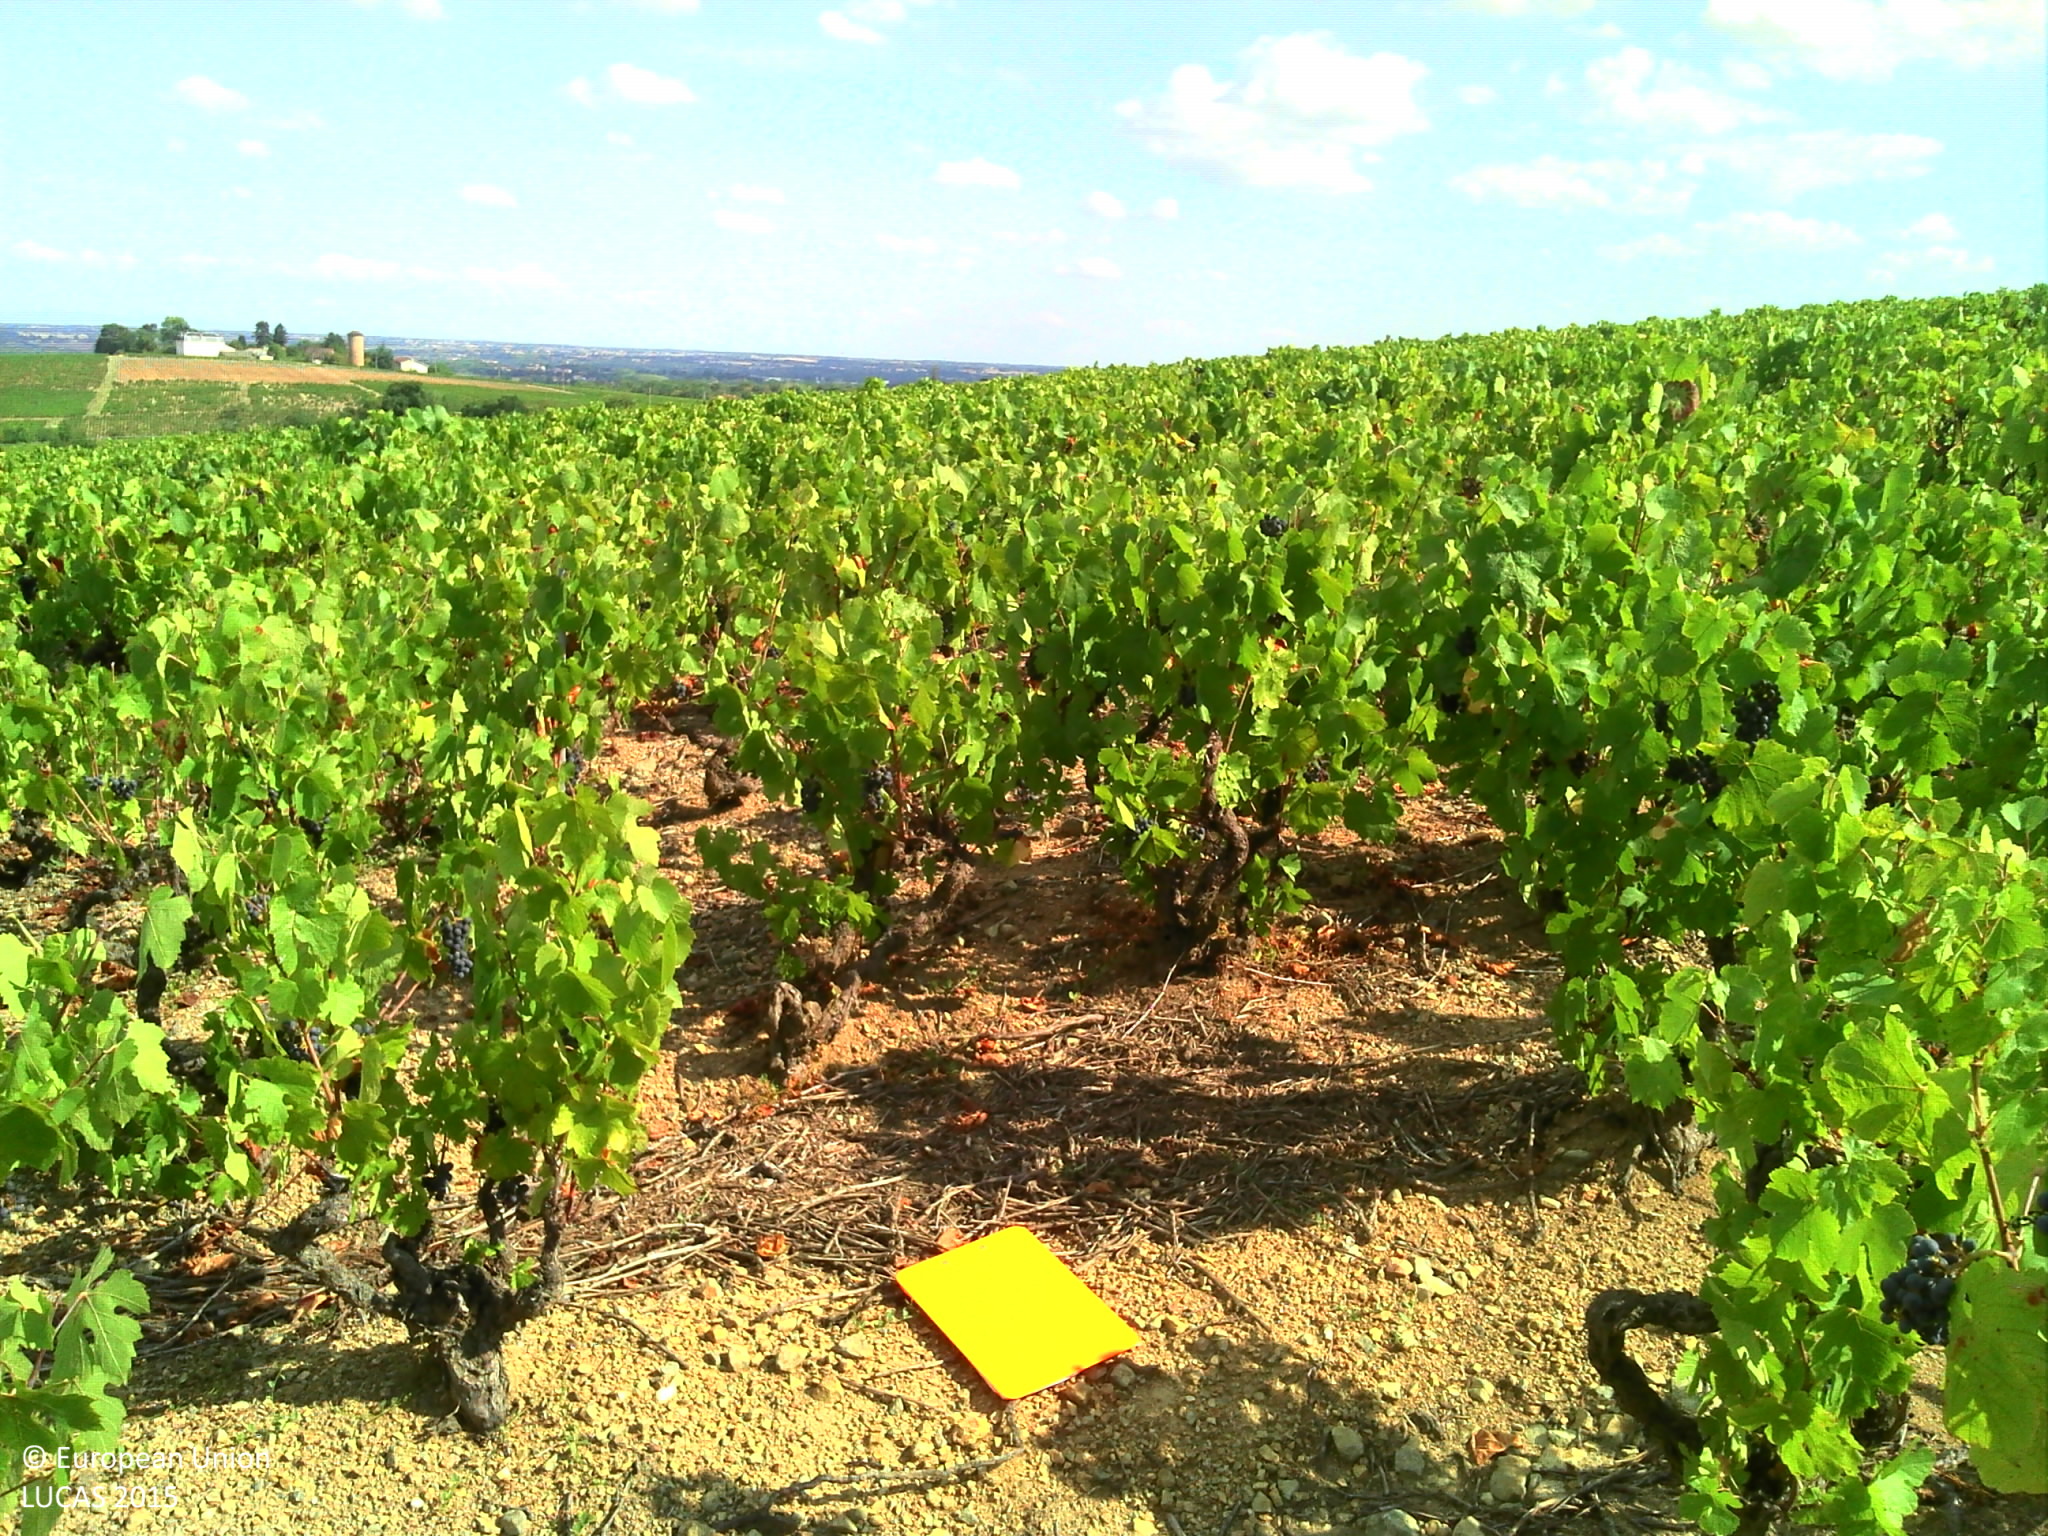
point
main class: Cropland
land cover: Vineyards
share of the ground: 50 - 75 %
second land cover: Other bare soil
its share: > 75 %
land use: Agriculture (excluding fallow land and kitchen gardens)
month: August
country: FR
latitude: 46.0915
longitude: 4.6609
